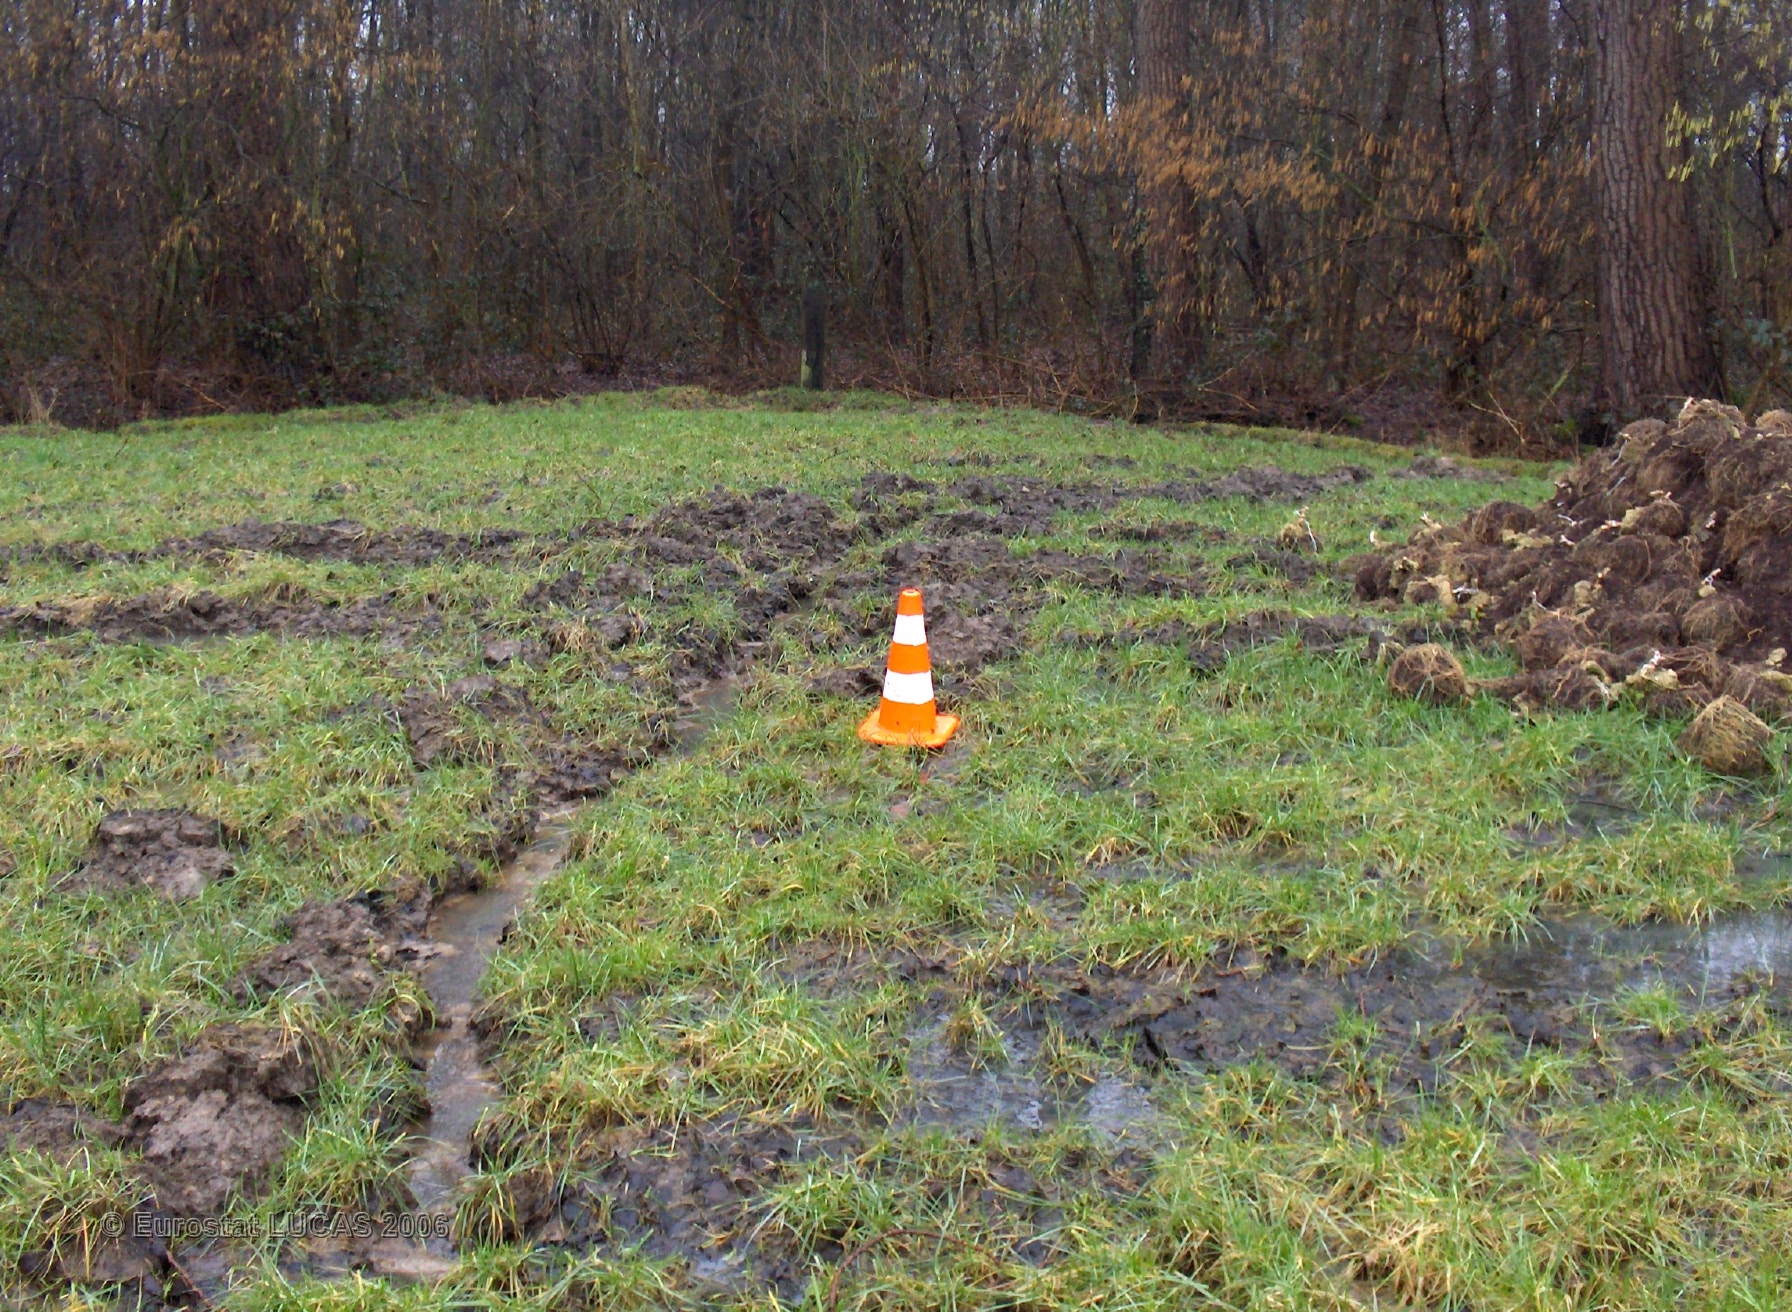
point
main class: Grassland
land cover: Grassland without tree/shrub cover
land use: Agriculture (excluding fallow land and kitchen gardens)
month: March
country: BE
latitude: 51.0954
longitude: 4.4697
